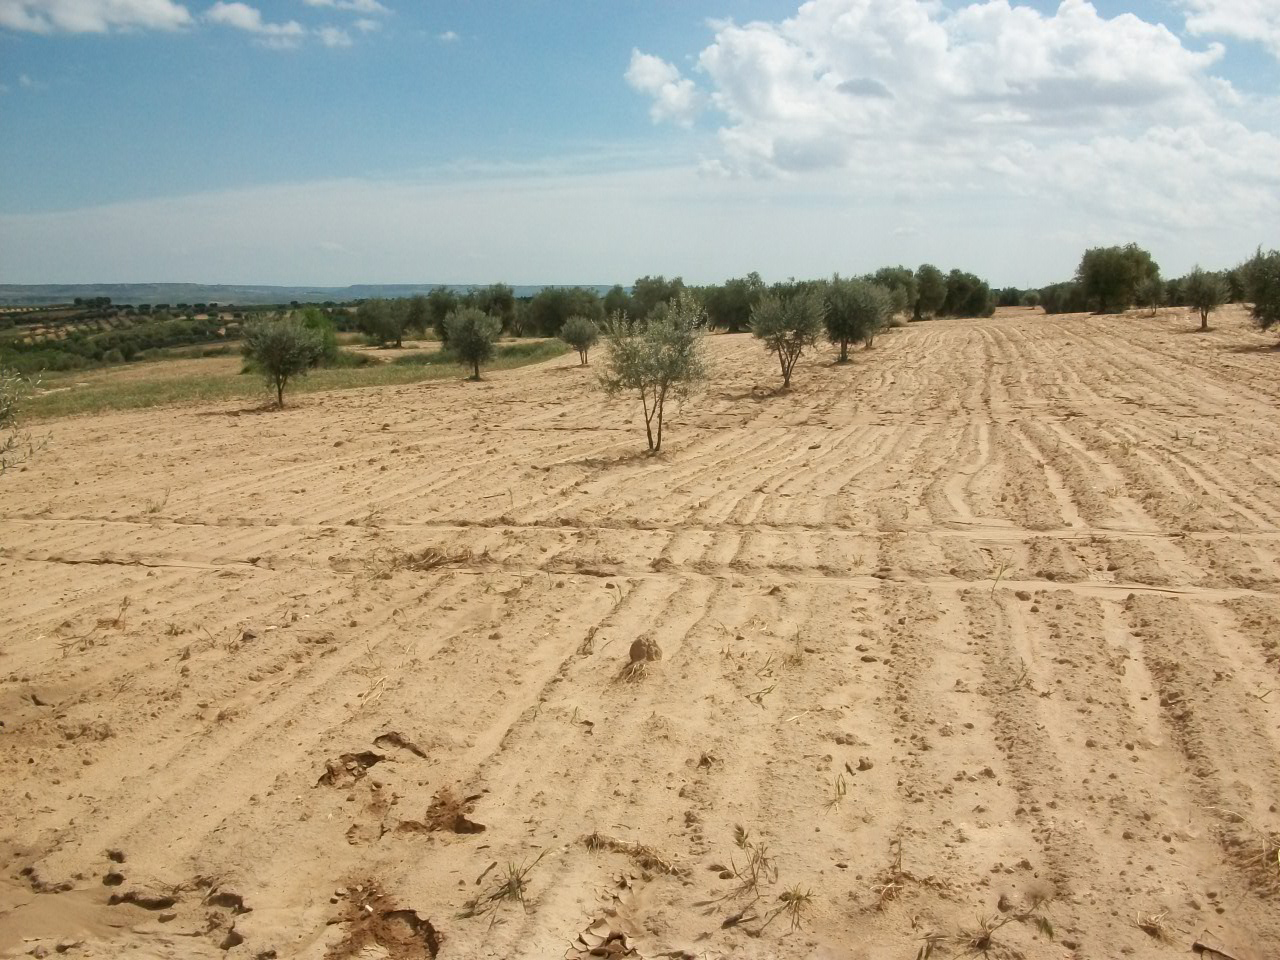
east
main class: Cropland
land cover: Olive groves
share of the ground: 10 - 25 %
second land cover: Other bare soil
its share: > 75 %
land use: Agriculture (excluding fallow land and kitchen gardens)
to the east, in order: Olive groves; Other bare soil; Tracks; Olive groves; Tracks; Grass margins; Abandoned hedges; Barley; Grass margins; Other bare soil
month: April
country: ES
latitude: 39.8454
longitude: -3.7392
